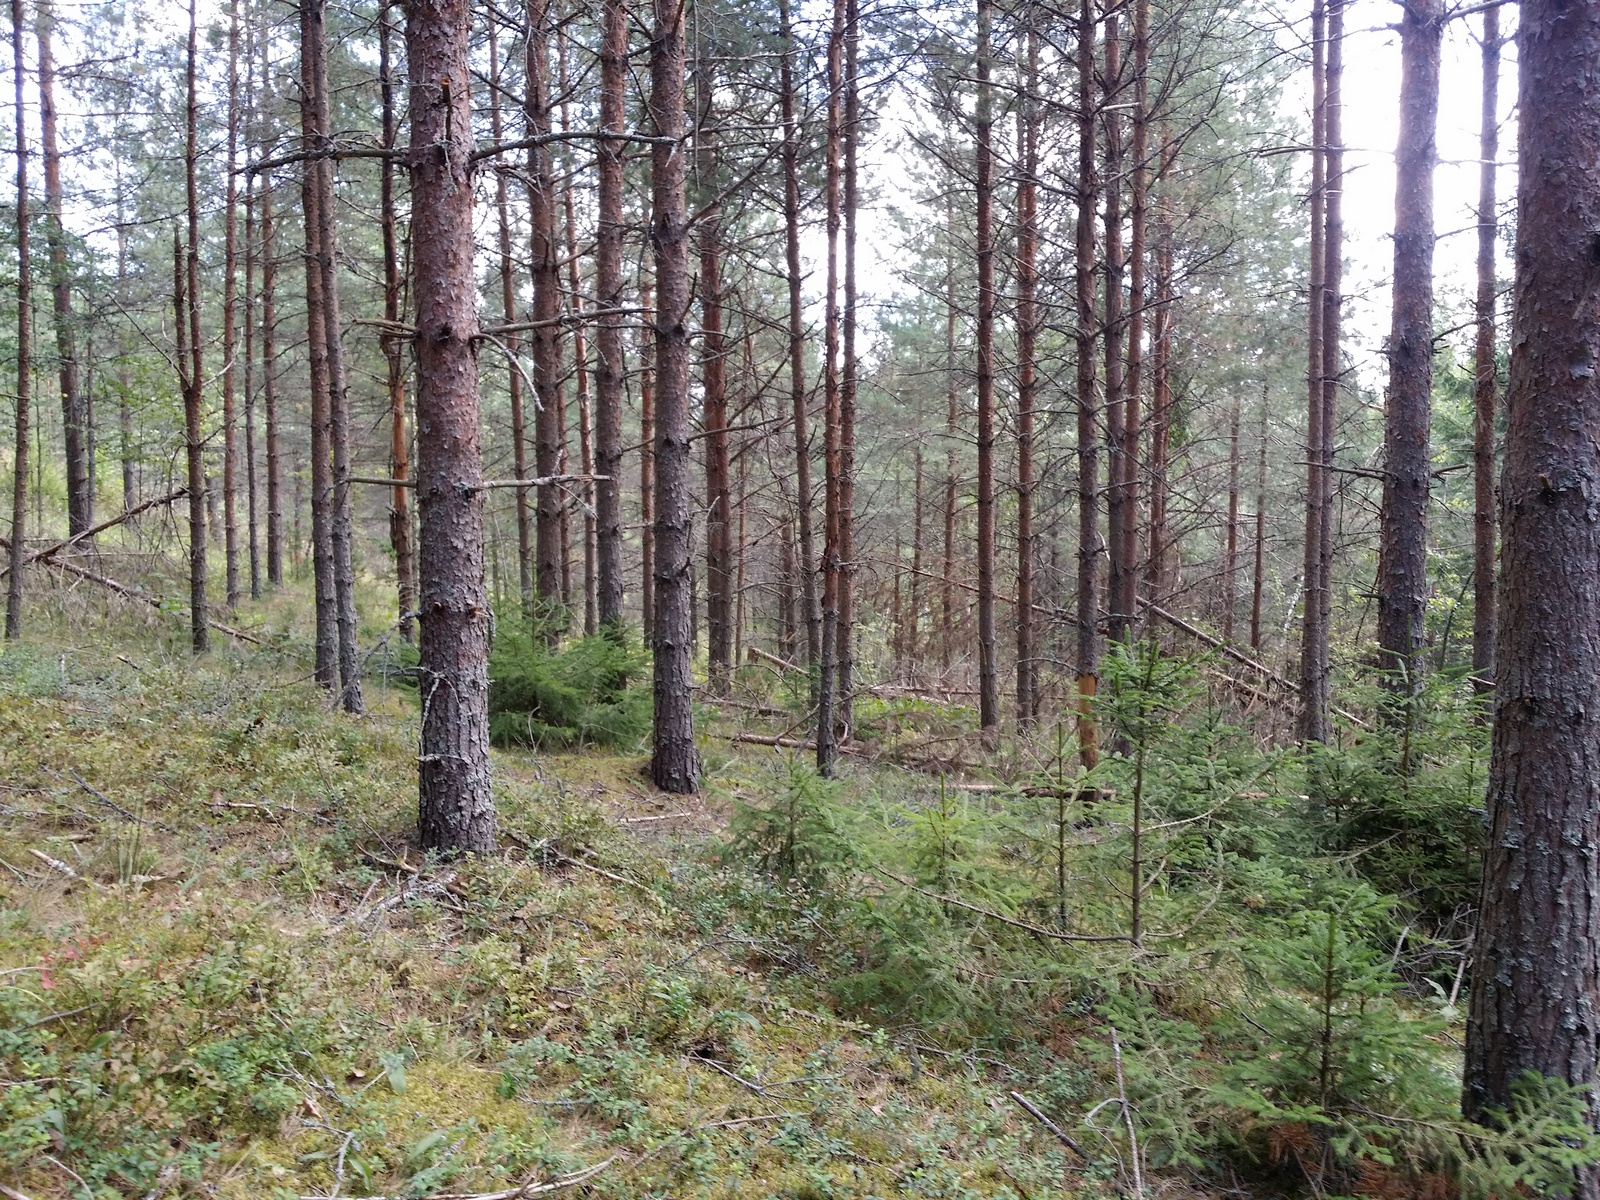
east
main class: Woodland
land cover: Other coniferous woodland
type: hemiboreal forest and nemoral coniferous forest and mixed broadleaved-coniferous forest
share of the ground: > 75 %
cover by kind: coniferous forest trees 80 %, shrubs 10 %, lichens and mosses 10 %
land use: Forestry
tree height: > 5 m
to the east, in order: Other coniferous woodland; Pine dominated coniferous woodland; Tracks; Spruce dominated coniferous woodland; Other coniferous woodland
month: August
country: LV
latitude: 56.8737
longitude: 27.6223
